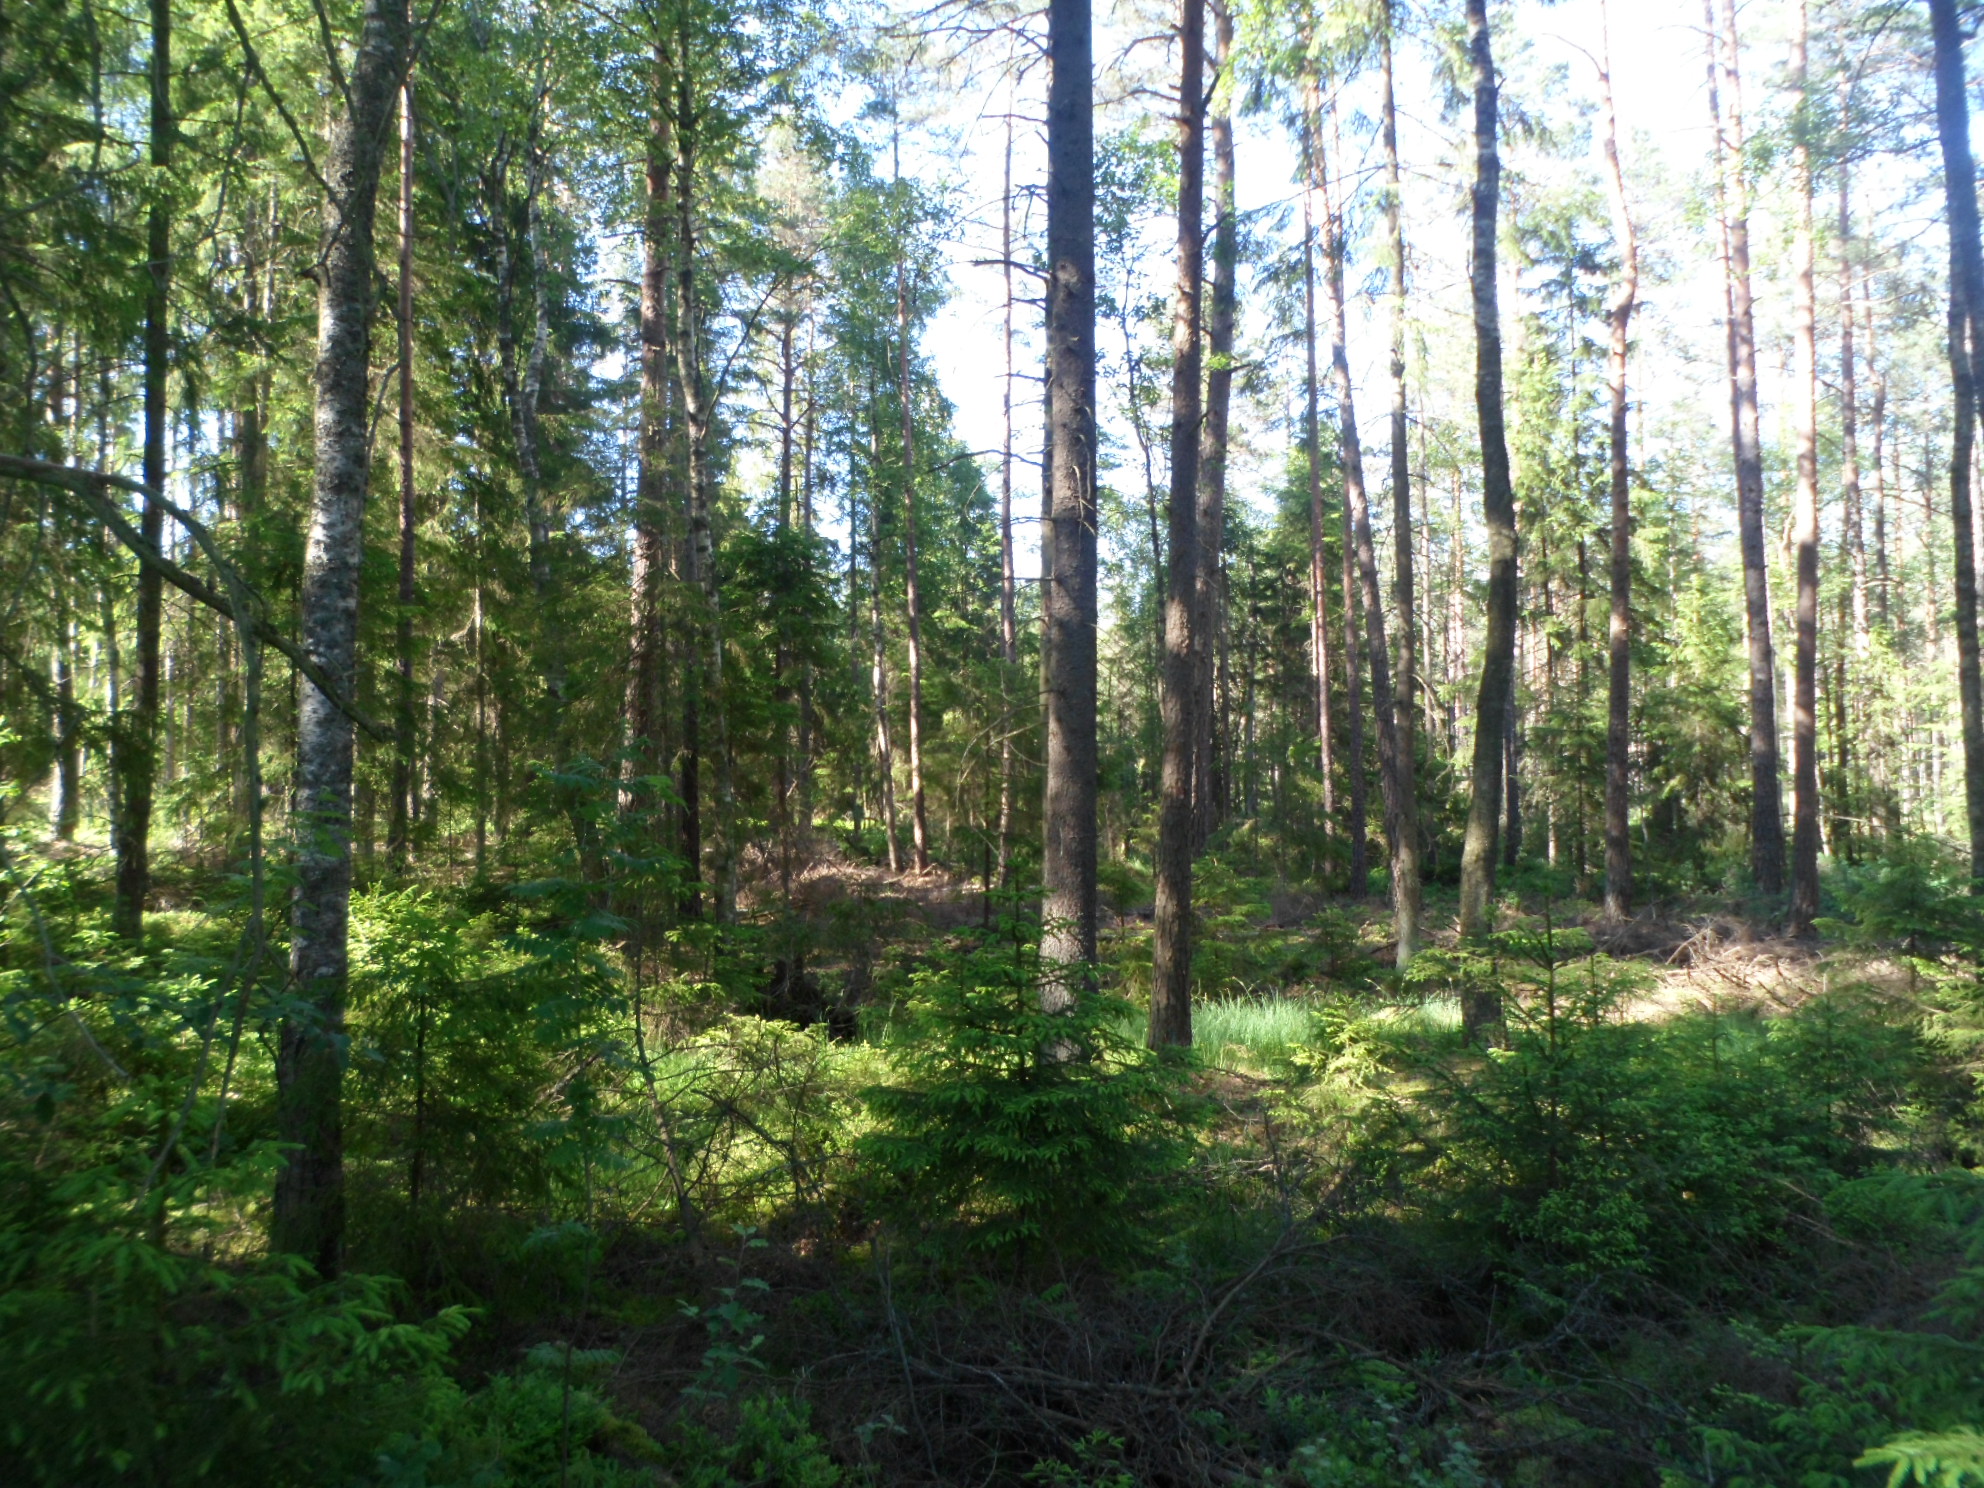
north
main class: Woodland
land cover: Spruce dominated coniferous woodland
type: boreal forest
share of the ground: 50 - 75 %
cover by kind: coniferous forest trees 55 %, shrubs 20 %, broadleaved forest trees 10 %, lichens and mosses 10 %, herbaceous plants 5 %
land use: Forestry
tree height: > 5 m
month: July
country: SE
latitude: 57.4331
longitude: 14.7431
